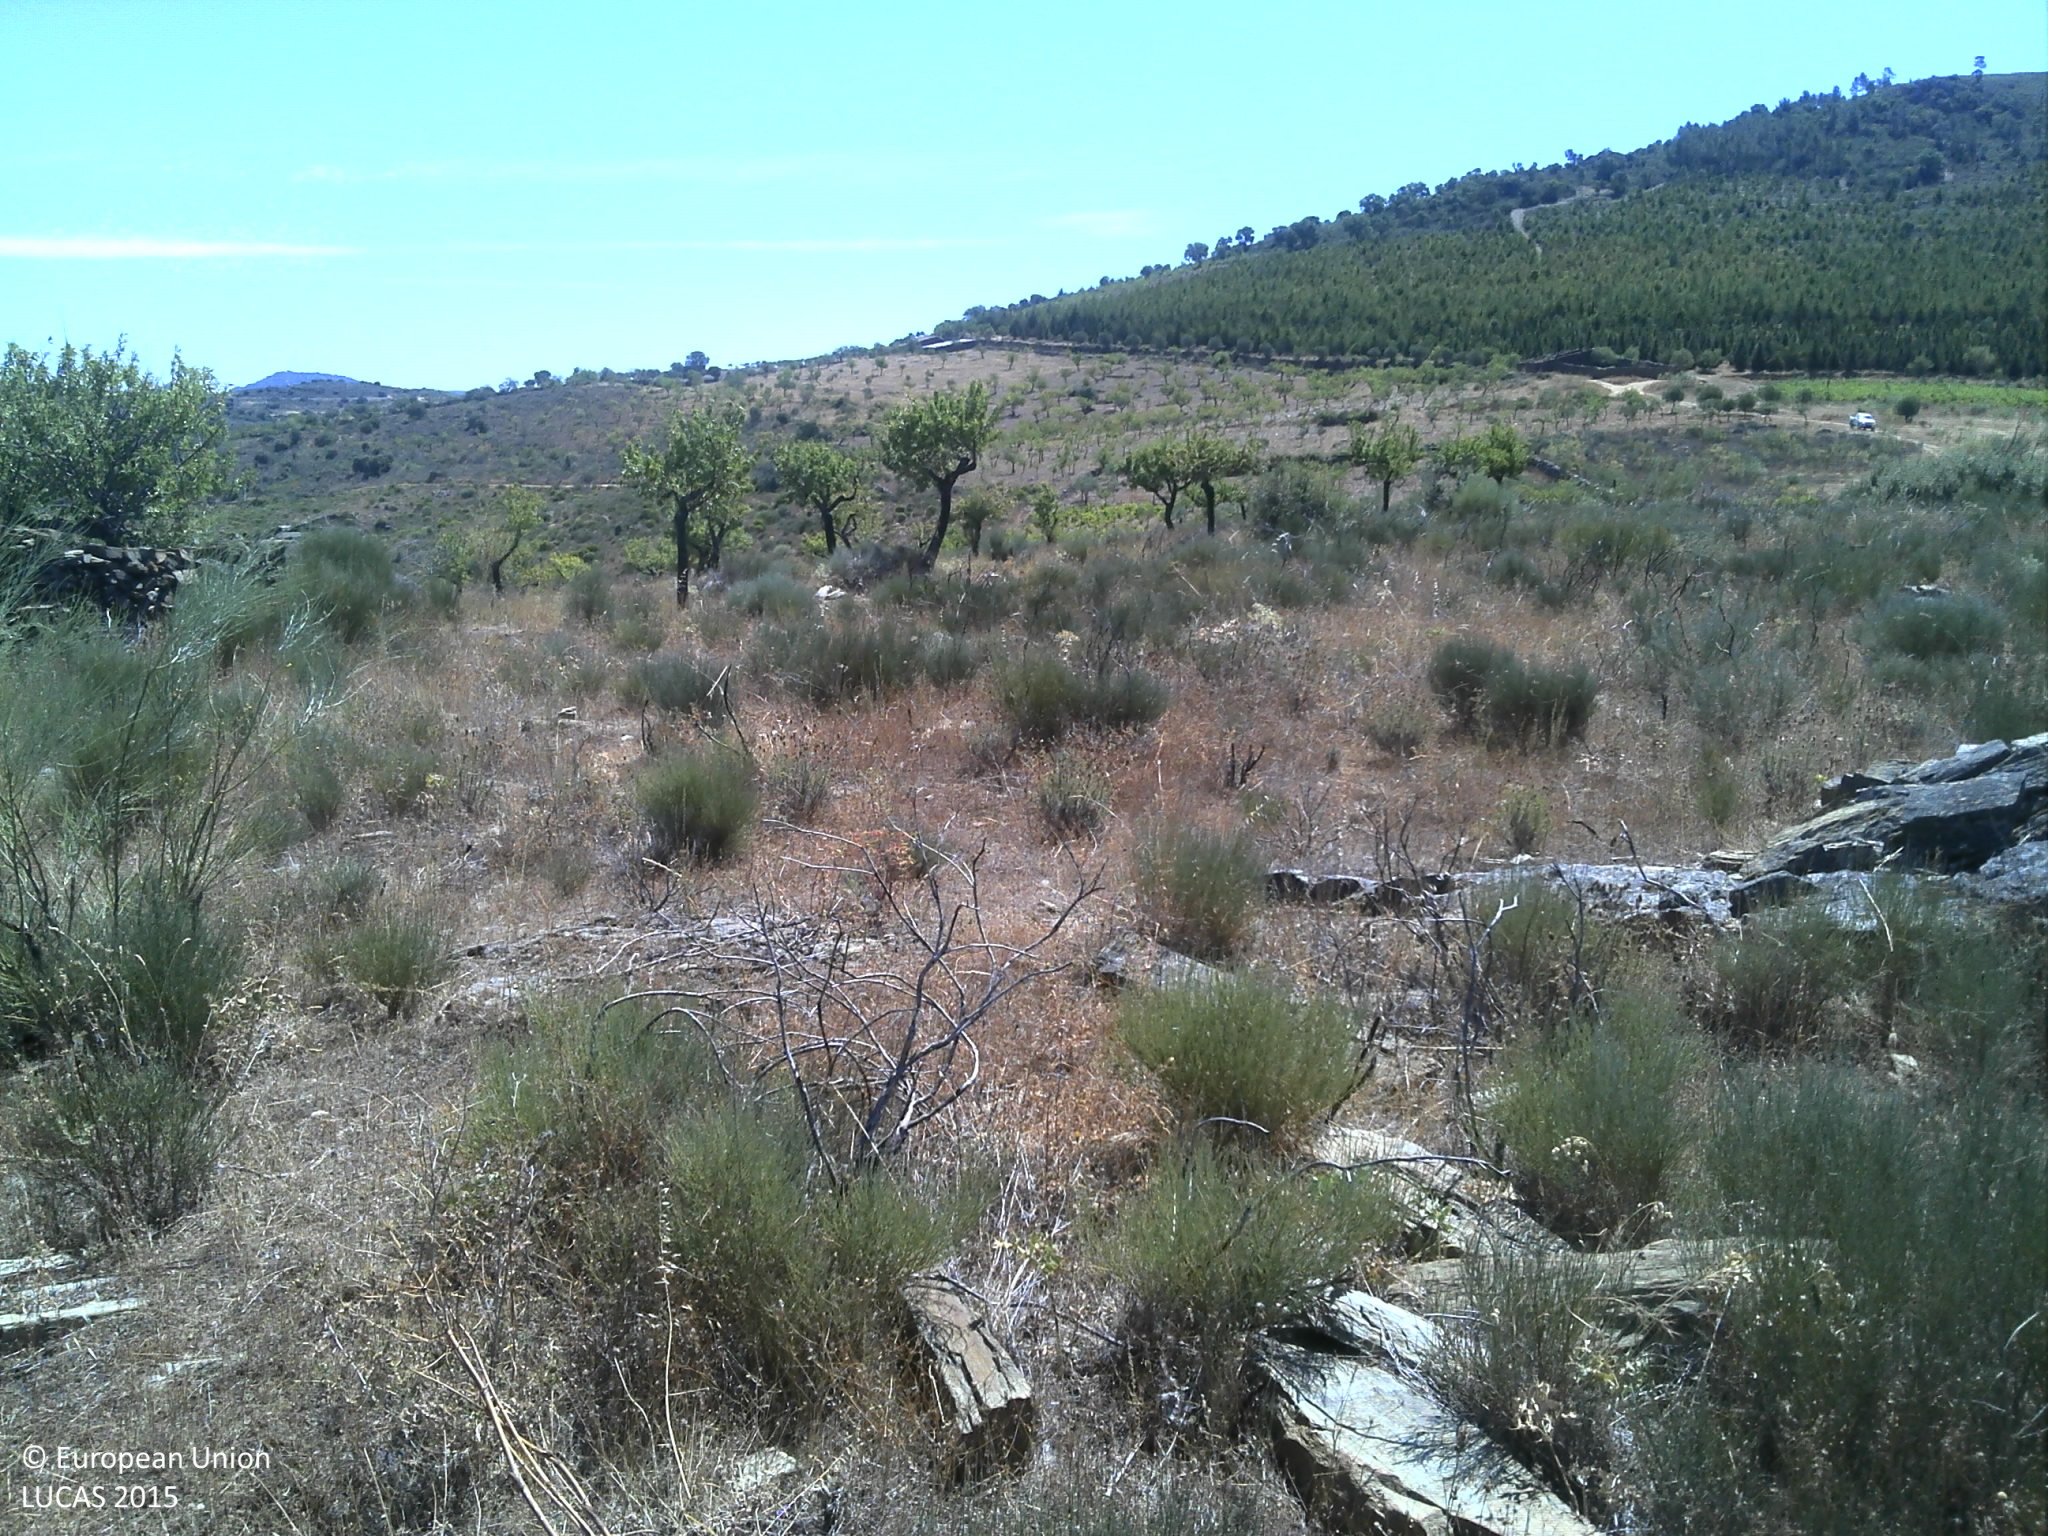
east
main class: Shrubland
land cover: Shrubland without tree cover
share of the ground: 50 - 75 %
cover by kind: shrubs 75 %, herbaceous plants 20 %, consolidated bare surface 5 %
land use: Abandoned areas
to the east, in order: Shrubland without tree cover; Rock outcrops; Shrubland without tree cover; Nuts trees; Shrubland without tree cover; Dry stone walls; Nuts trees; Vineyards; Dry stone walls; Shrubland without tree cover; Nuts trees
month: July
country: PT
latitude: 41.0855
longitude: -7.0486
